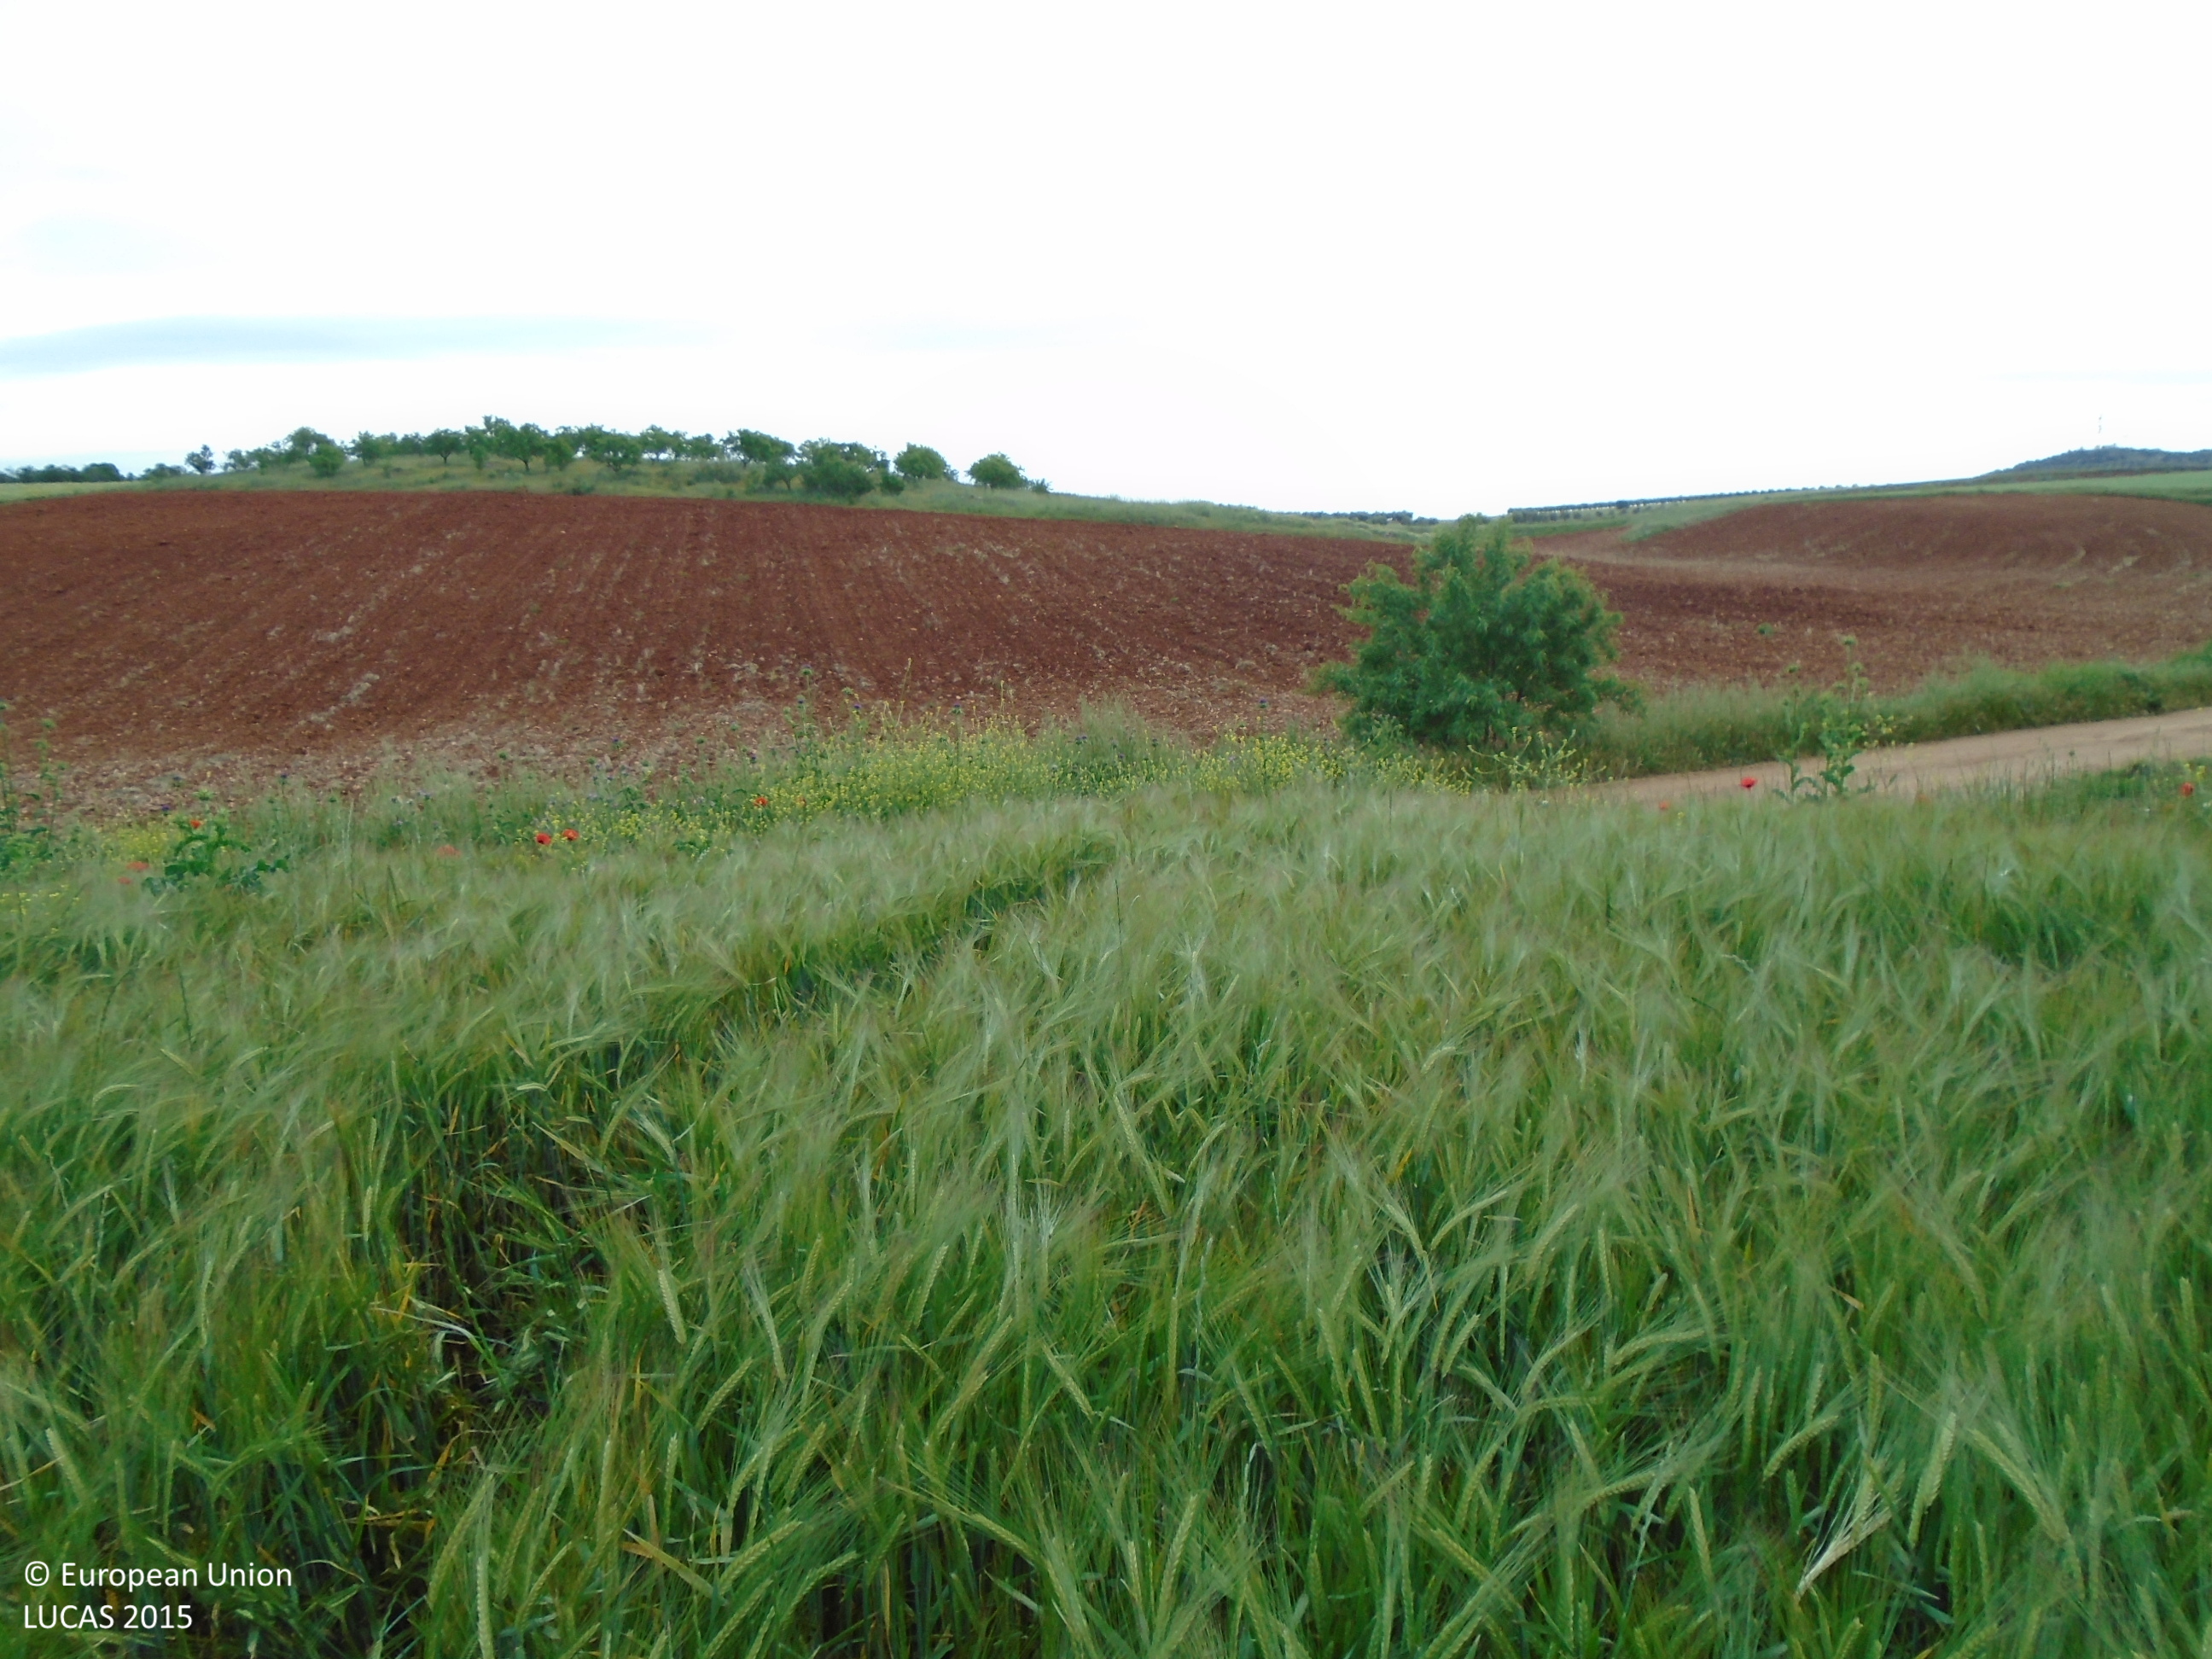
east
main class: Cropland
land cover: Barley
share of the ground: > 75 %
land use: Agriculture (excluding fallow land and kitchen gardens)
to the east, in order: Barley; Grass margins; Tracks; Grass margins; Other bare soil; Spontaneously vegetated surfaces; Other bare soil; Spontaneously vegetated surfaces; Grass margins; Oats
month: May
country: ES
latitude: 39.7283
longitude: -4.6607
